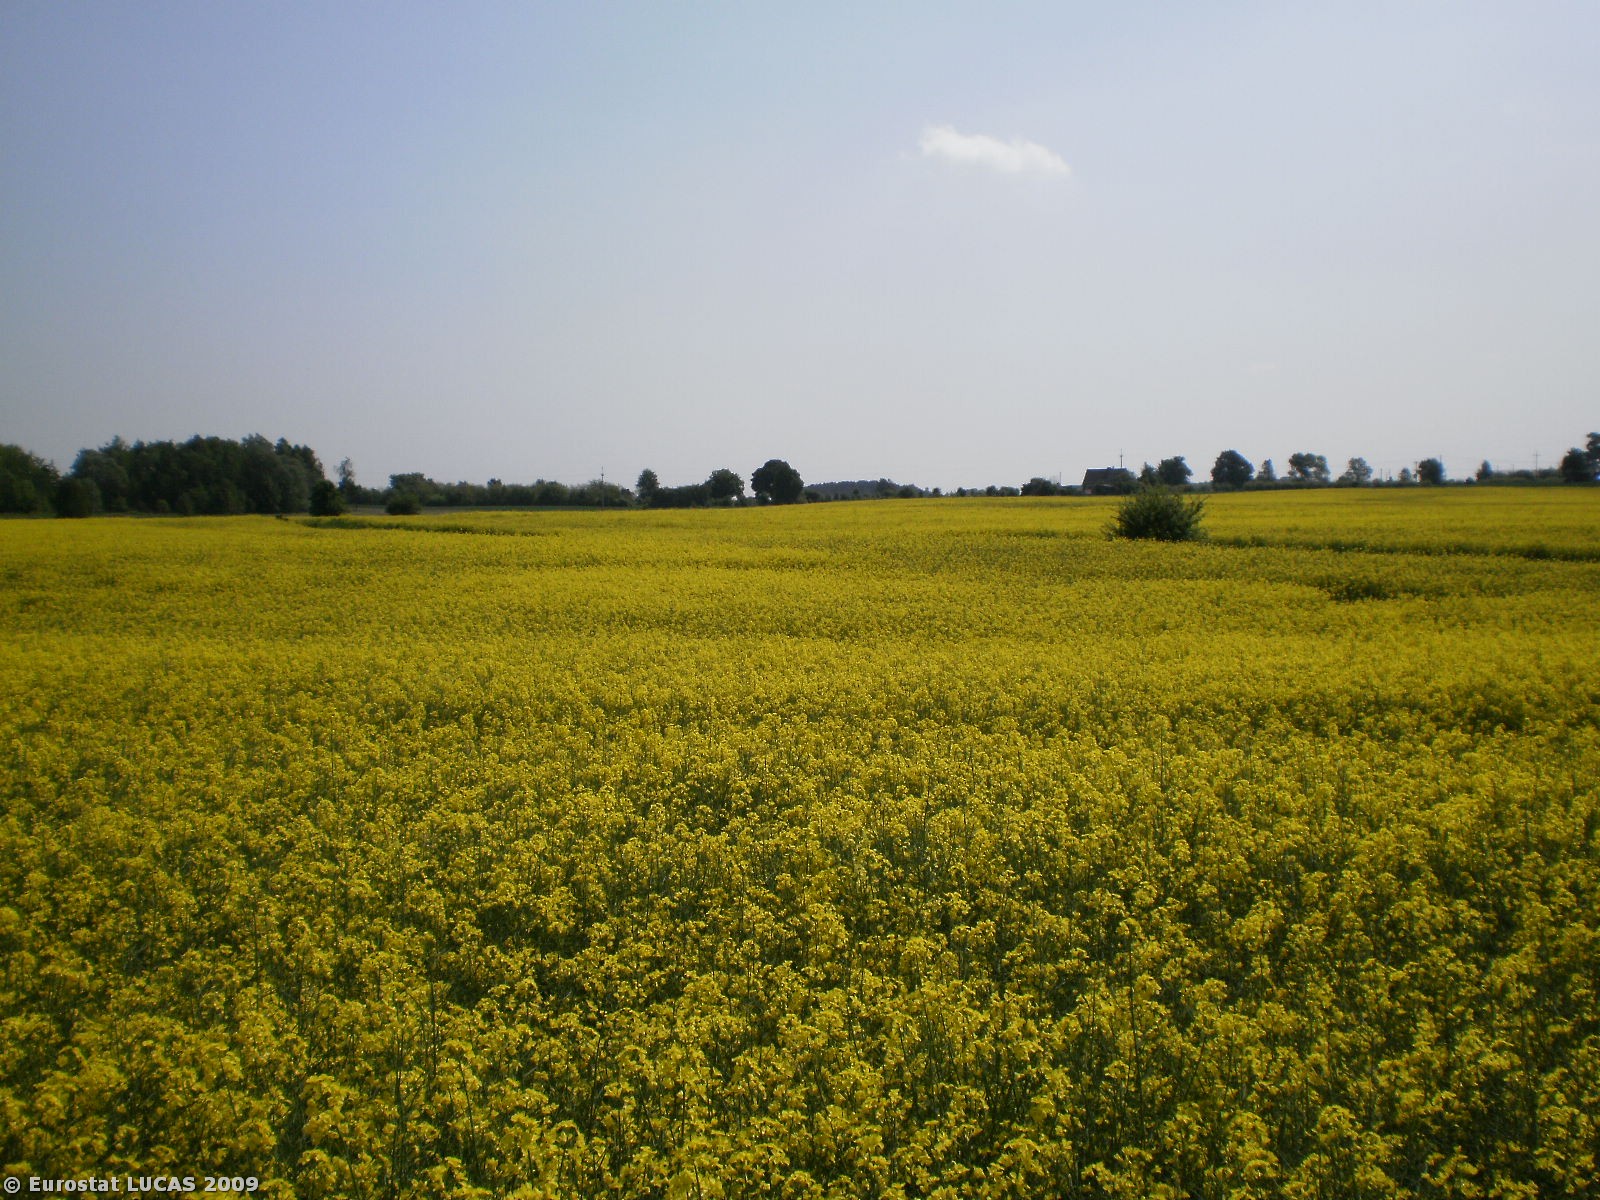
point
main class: Cropland
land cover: Rape and turnip rape
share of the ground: > 75 %
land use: Agriculture (excluding fallow land and kitchen gardens)
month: May
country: PL
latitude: 53.3662
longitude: 18.0856
